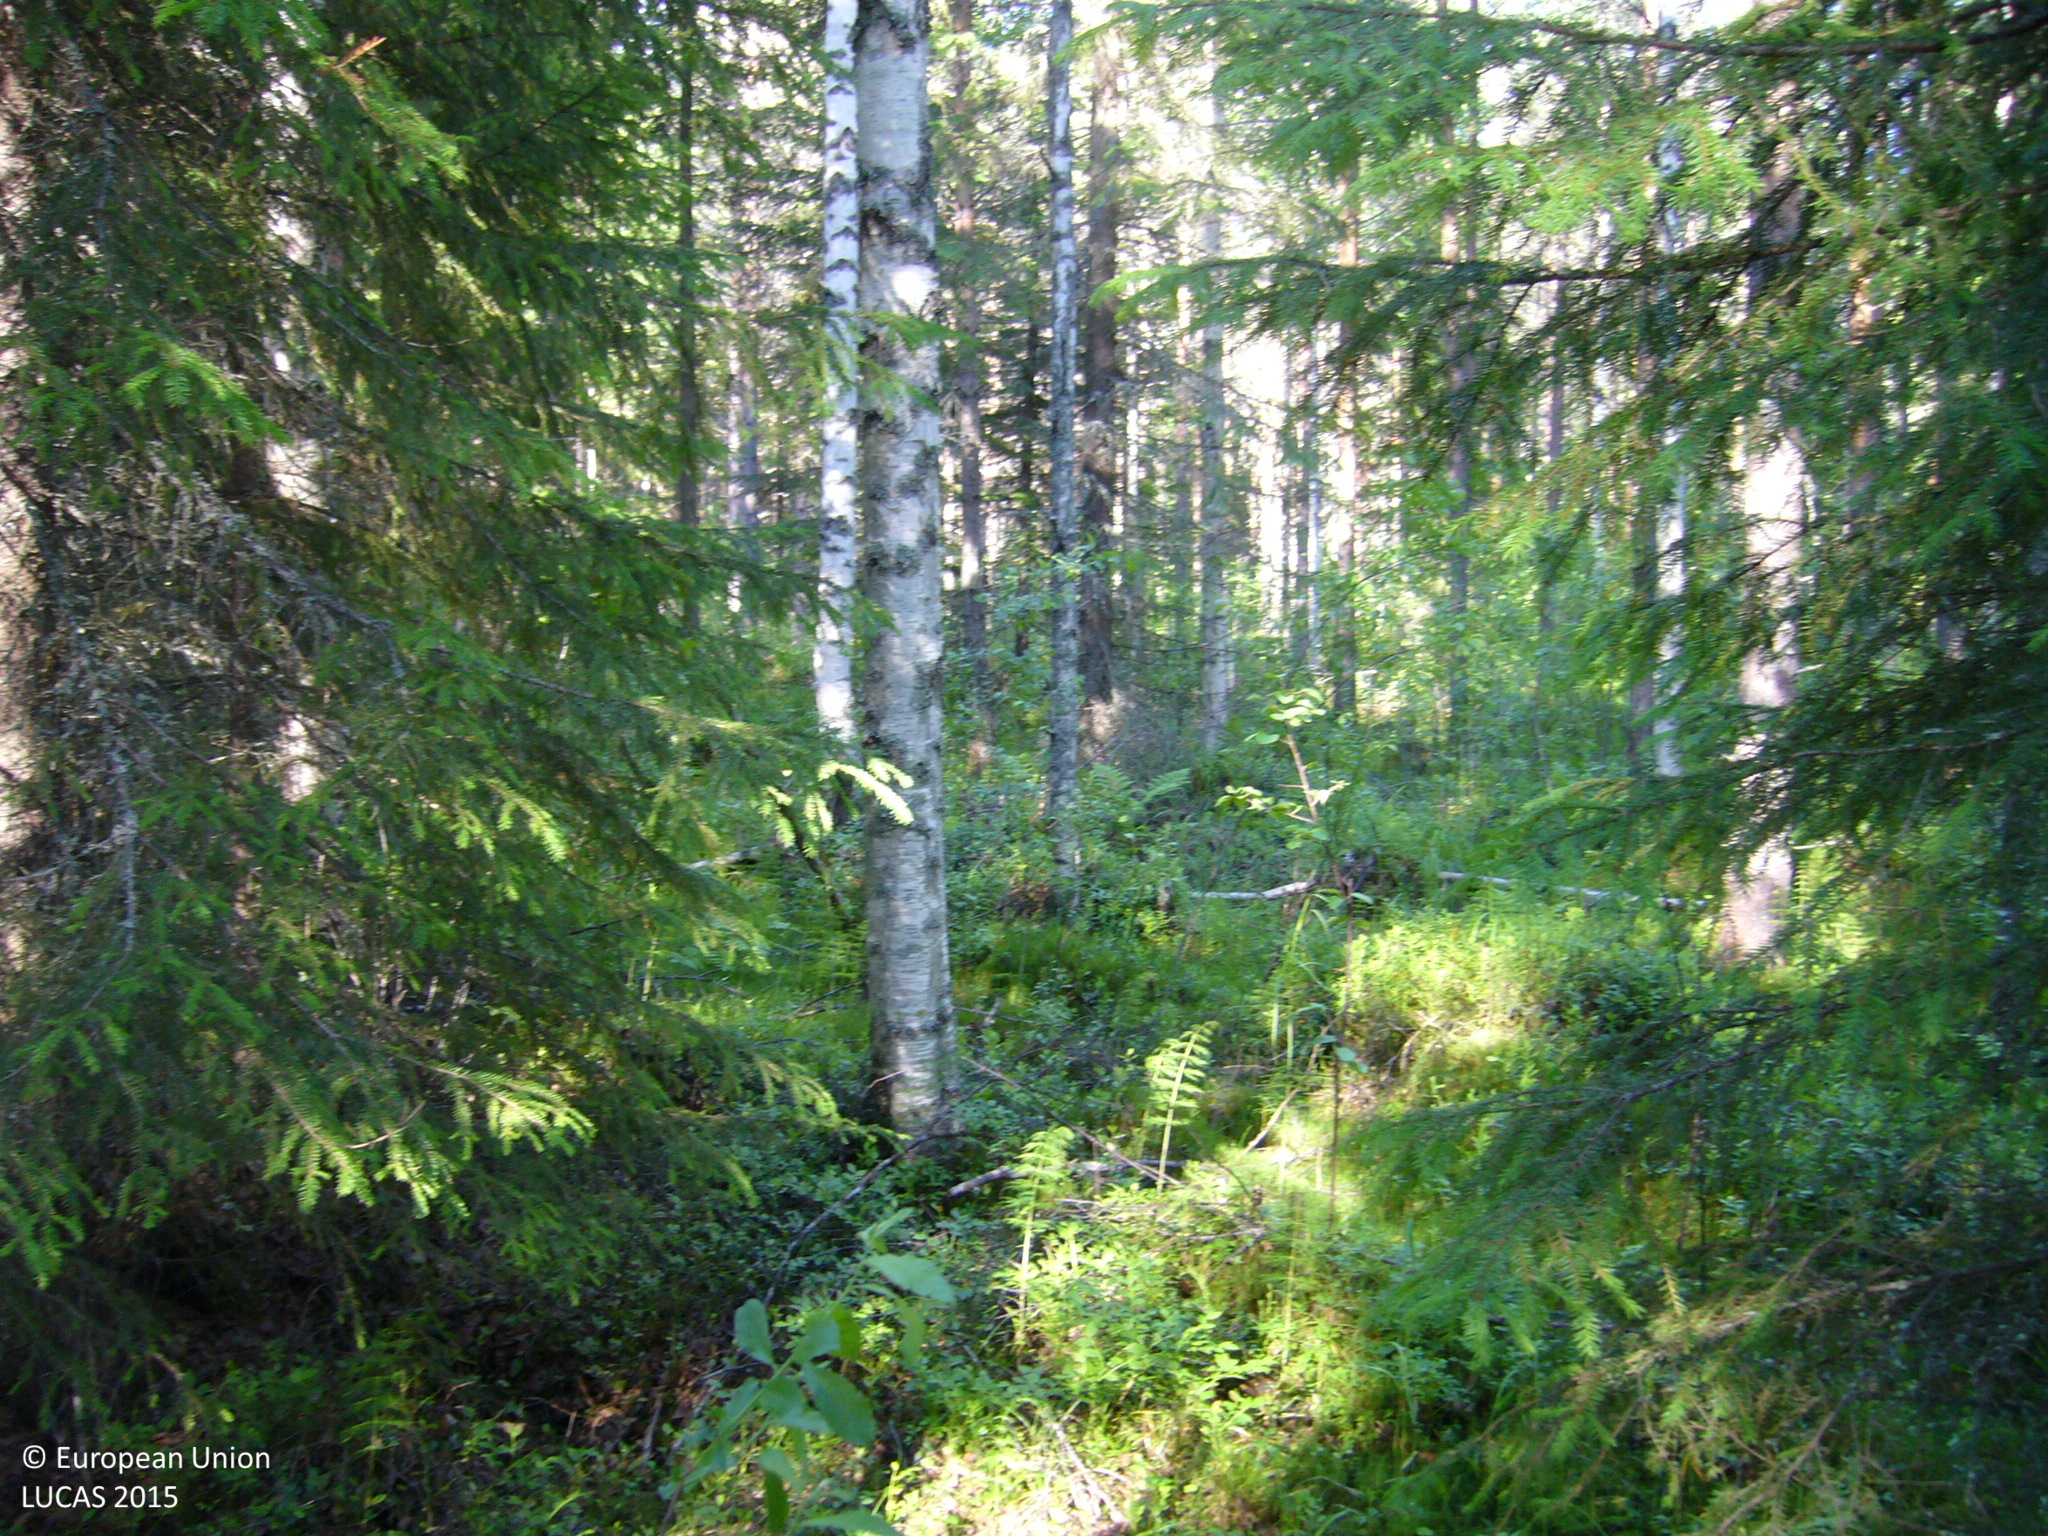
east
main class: Woodland
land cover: Spruce dominated mixed woodland
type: boreal forest
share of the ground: > 75 %
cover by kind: coniferous forest trees 50 %, broadleaved forest trees 40 %, shrubs 10 %
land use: Forestry
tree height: > 5 m
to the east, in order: Spruce dominated mixed woodland; Pine dominated mixed woodland; Spruce dominated mixed woodland; Shruby margins; Ditches and canals; Grass margins; Paved roads, cycling and walking lanes; Grass margins; Ditches and canals; Shruby margins; Pine dominated mixed woodland
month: July
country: FI
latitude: 63.5015
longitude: 26.3751
